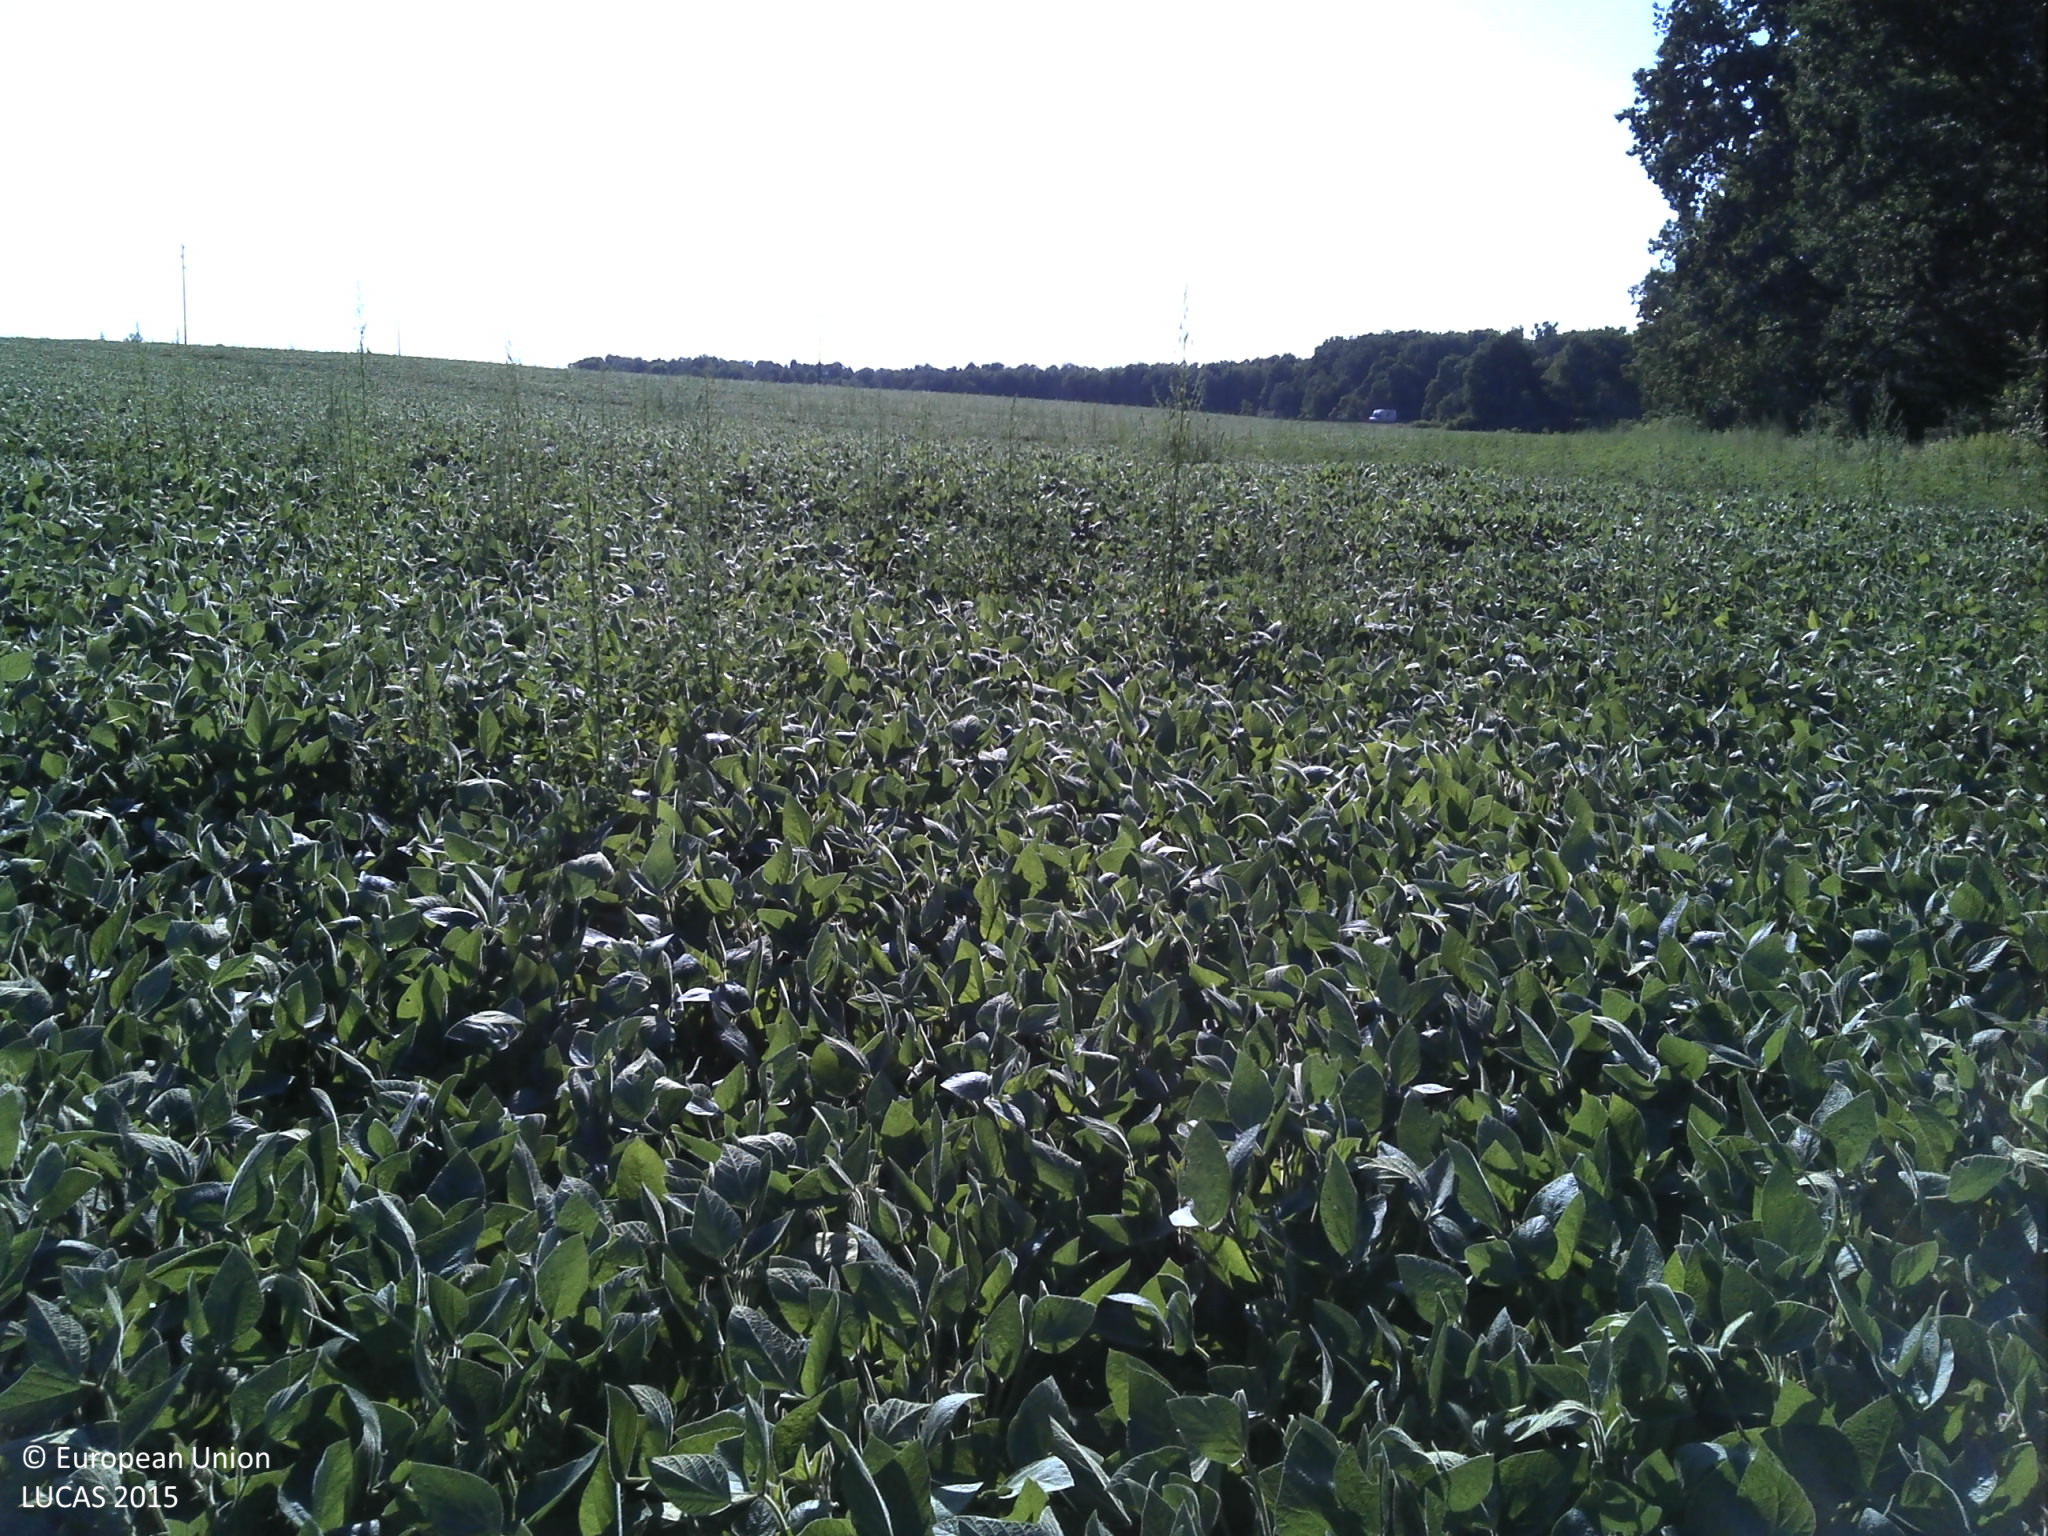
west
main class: Cropland
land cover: Soya
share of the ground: > 75 %
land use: Agriculture (excluding fallow land and kitchen gardens)
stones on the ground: < 10 %
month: July
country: HR
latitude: 45.4077
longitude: 16.8600
